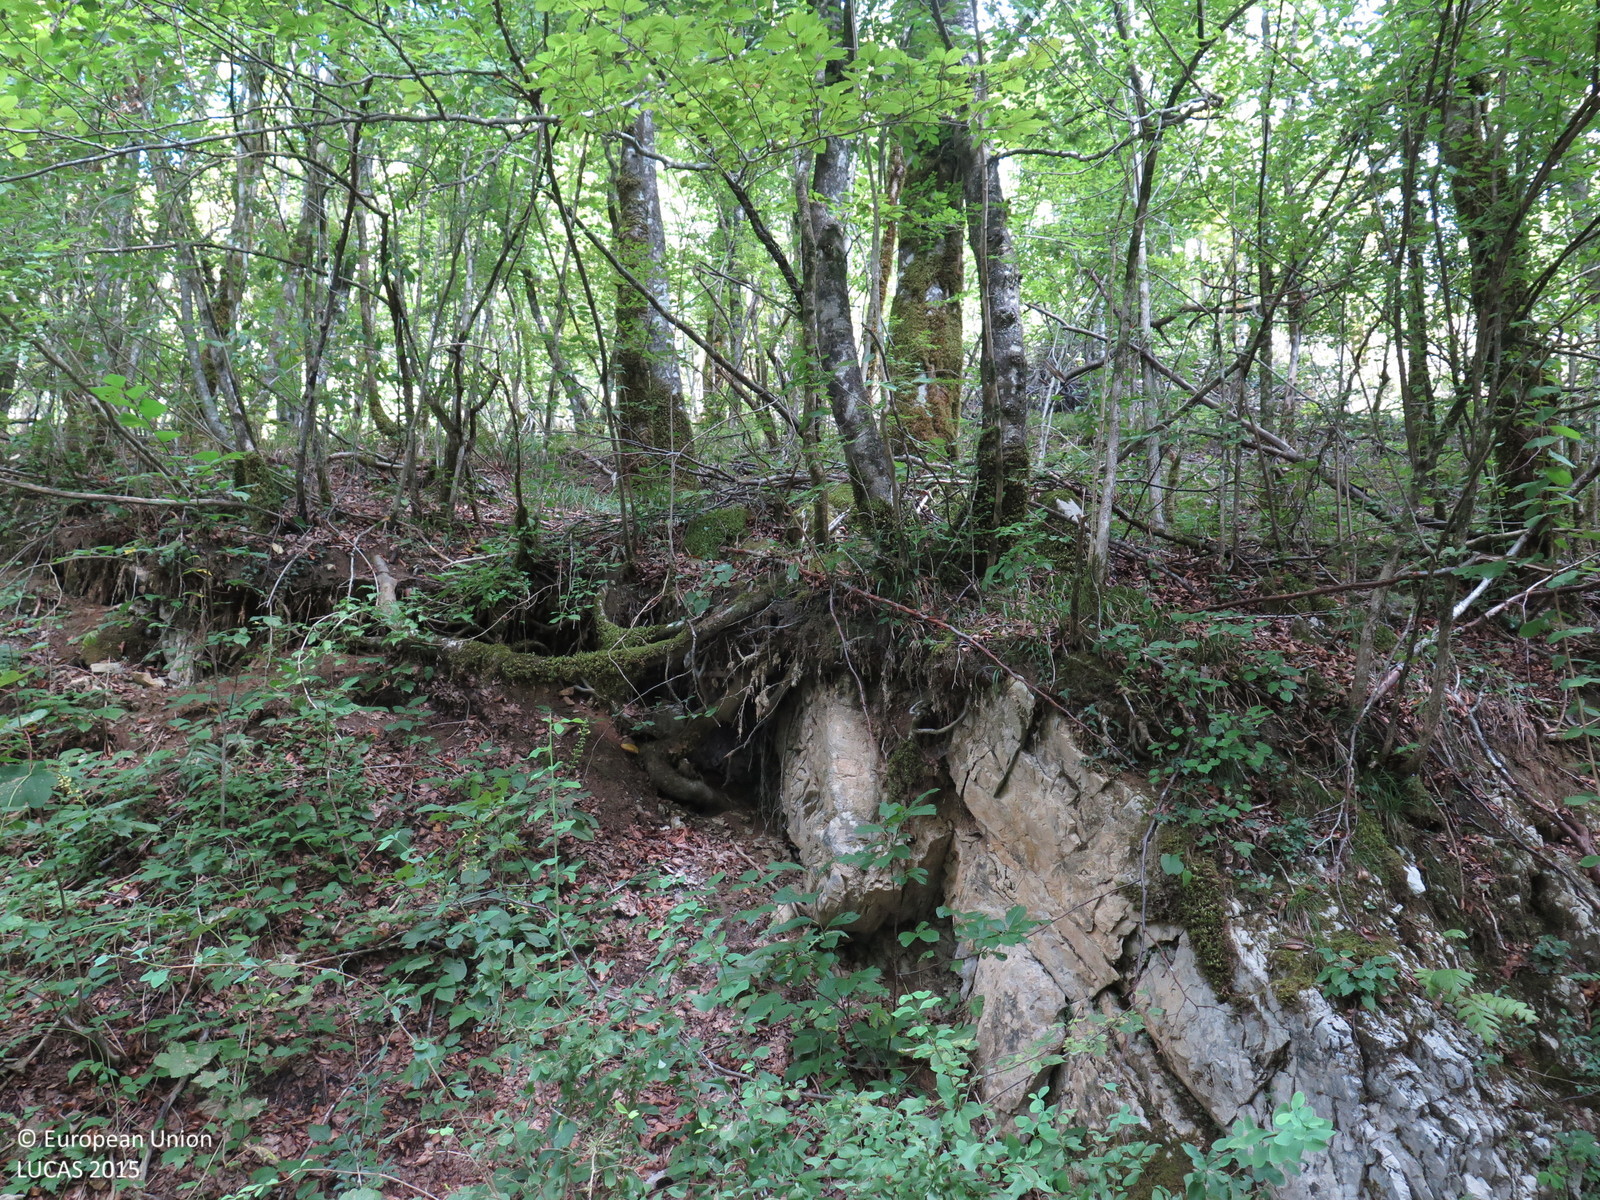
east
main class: Woodland
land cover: Broadleaved woodland
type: beech forest
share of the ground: > 75 %
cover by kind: broadleaved forest trees 90 %, shrubs 5 %, herbaceous plants 5 %
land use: Forestry
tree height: > 5 m
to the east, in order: Broadleaved woodland; Tracks; Broadleaved woodland; Inland fresh running water; Other mixed woodland; Pine dominated coniferous woodland; Other mixed woodland
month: September
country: HR
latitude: 45.4870
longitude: 14.7679
